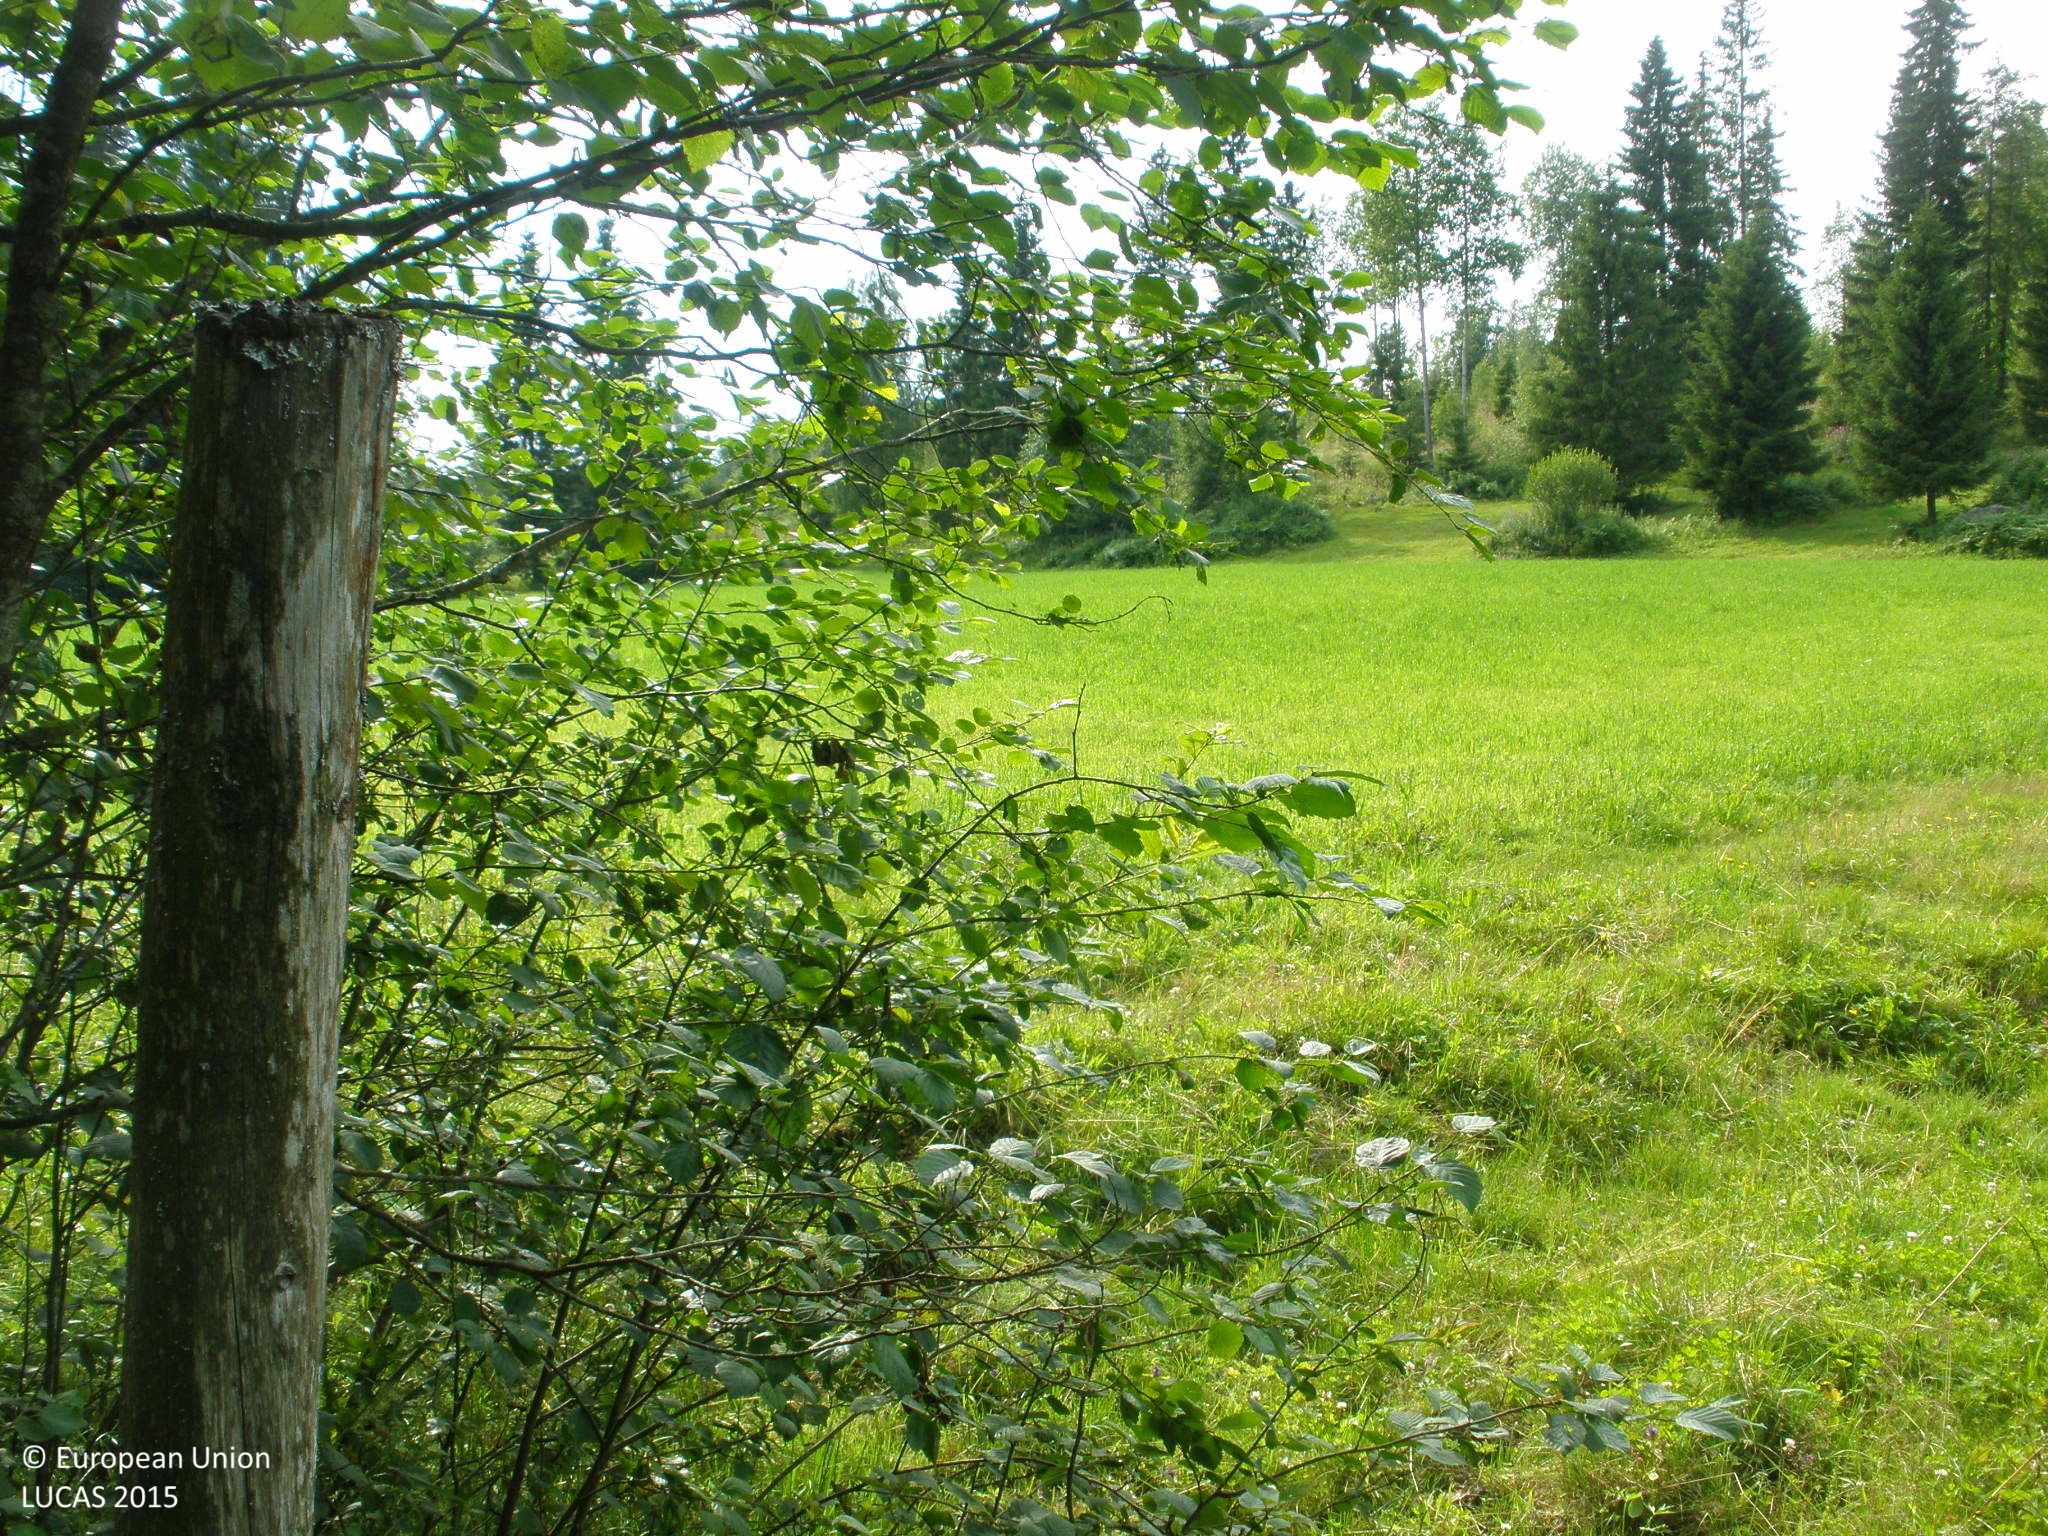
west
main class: Grassland
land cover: Grassland without tree/shrub cover
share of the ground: > 75 %
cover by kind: herbaceous plants 100 %
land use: Agriculture (excluding fallow land and kitchen gardens)
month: July
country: FI
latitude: 61.1326
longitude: 25.2134
